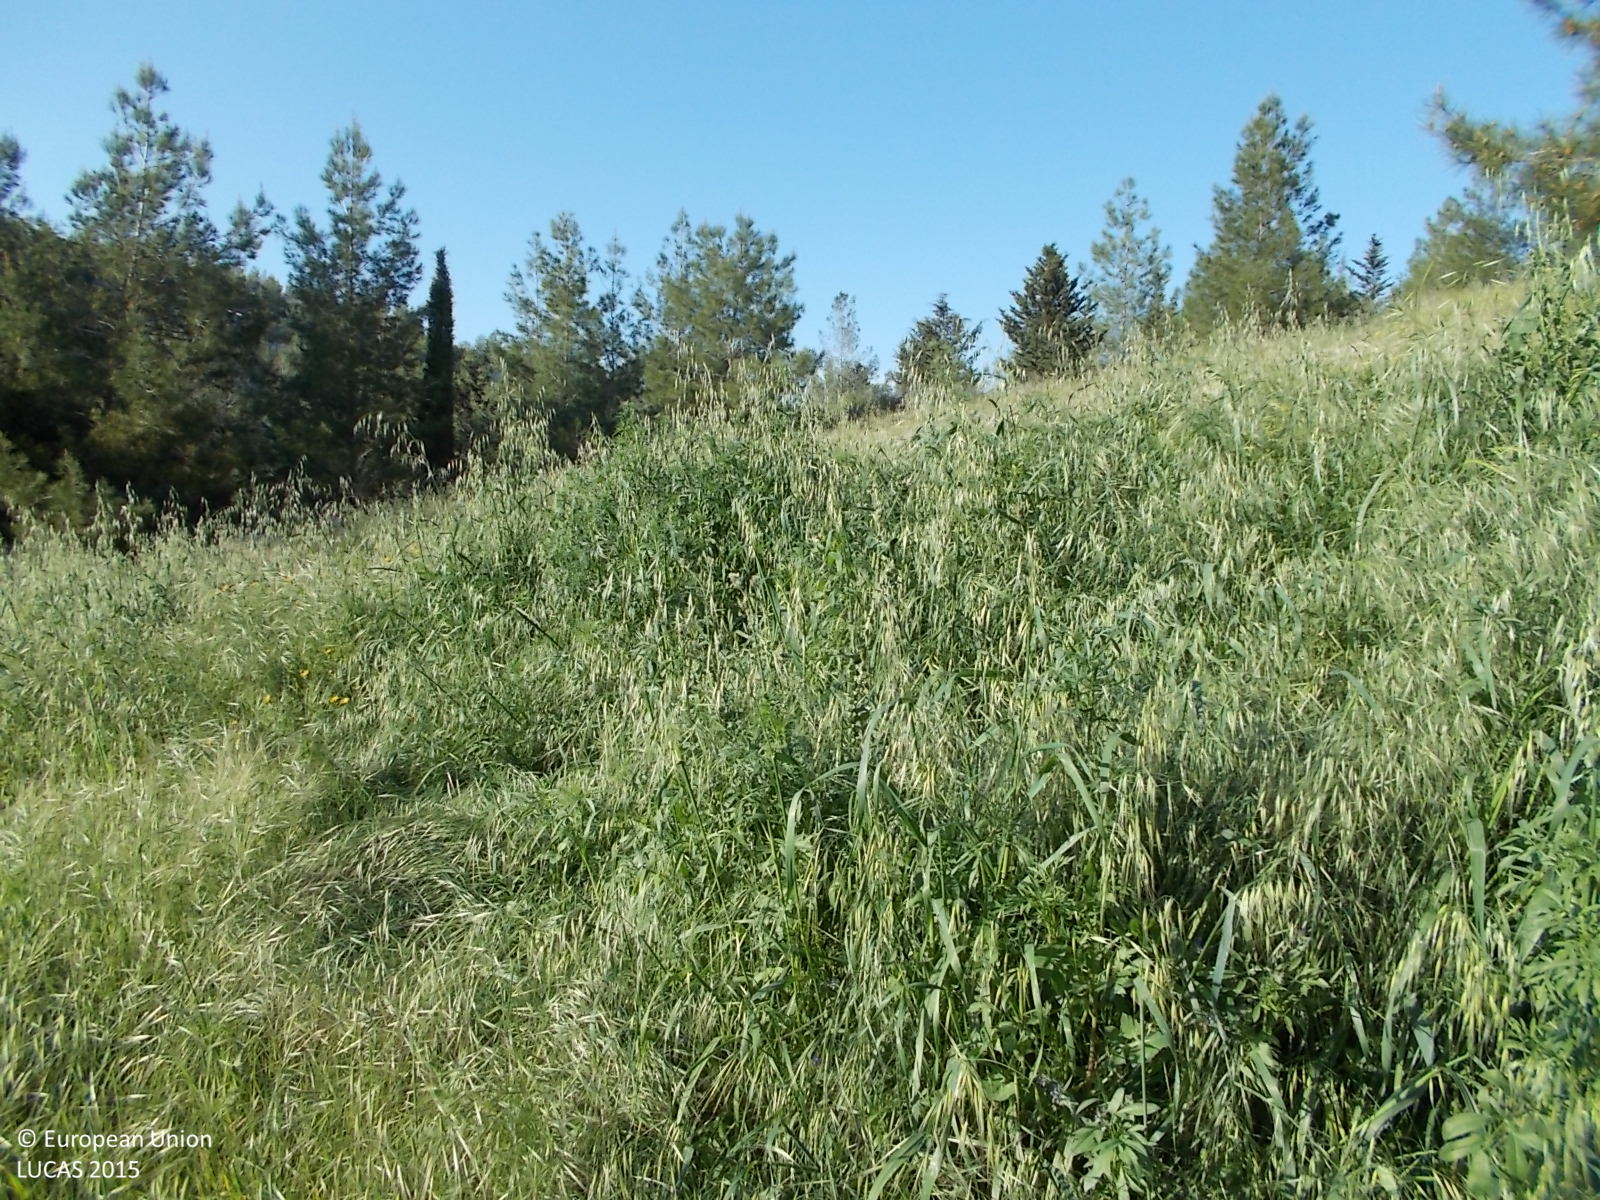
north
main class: Grassland
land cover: Grassland without tree/shrub cover
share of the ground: > 75 %
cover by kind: herbaceous plants 85 %, unconsolidated bare surface 15 %
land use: Semi-natural and natural areas not in use
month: April
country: CY
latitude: 34.9571
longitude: 33.5304
